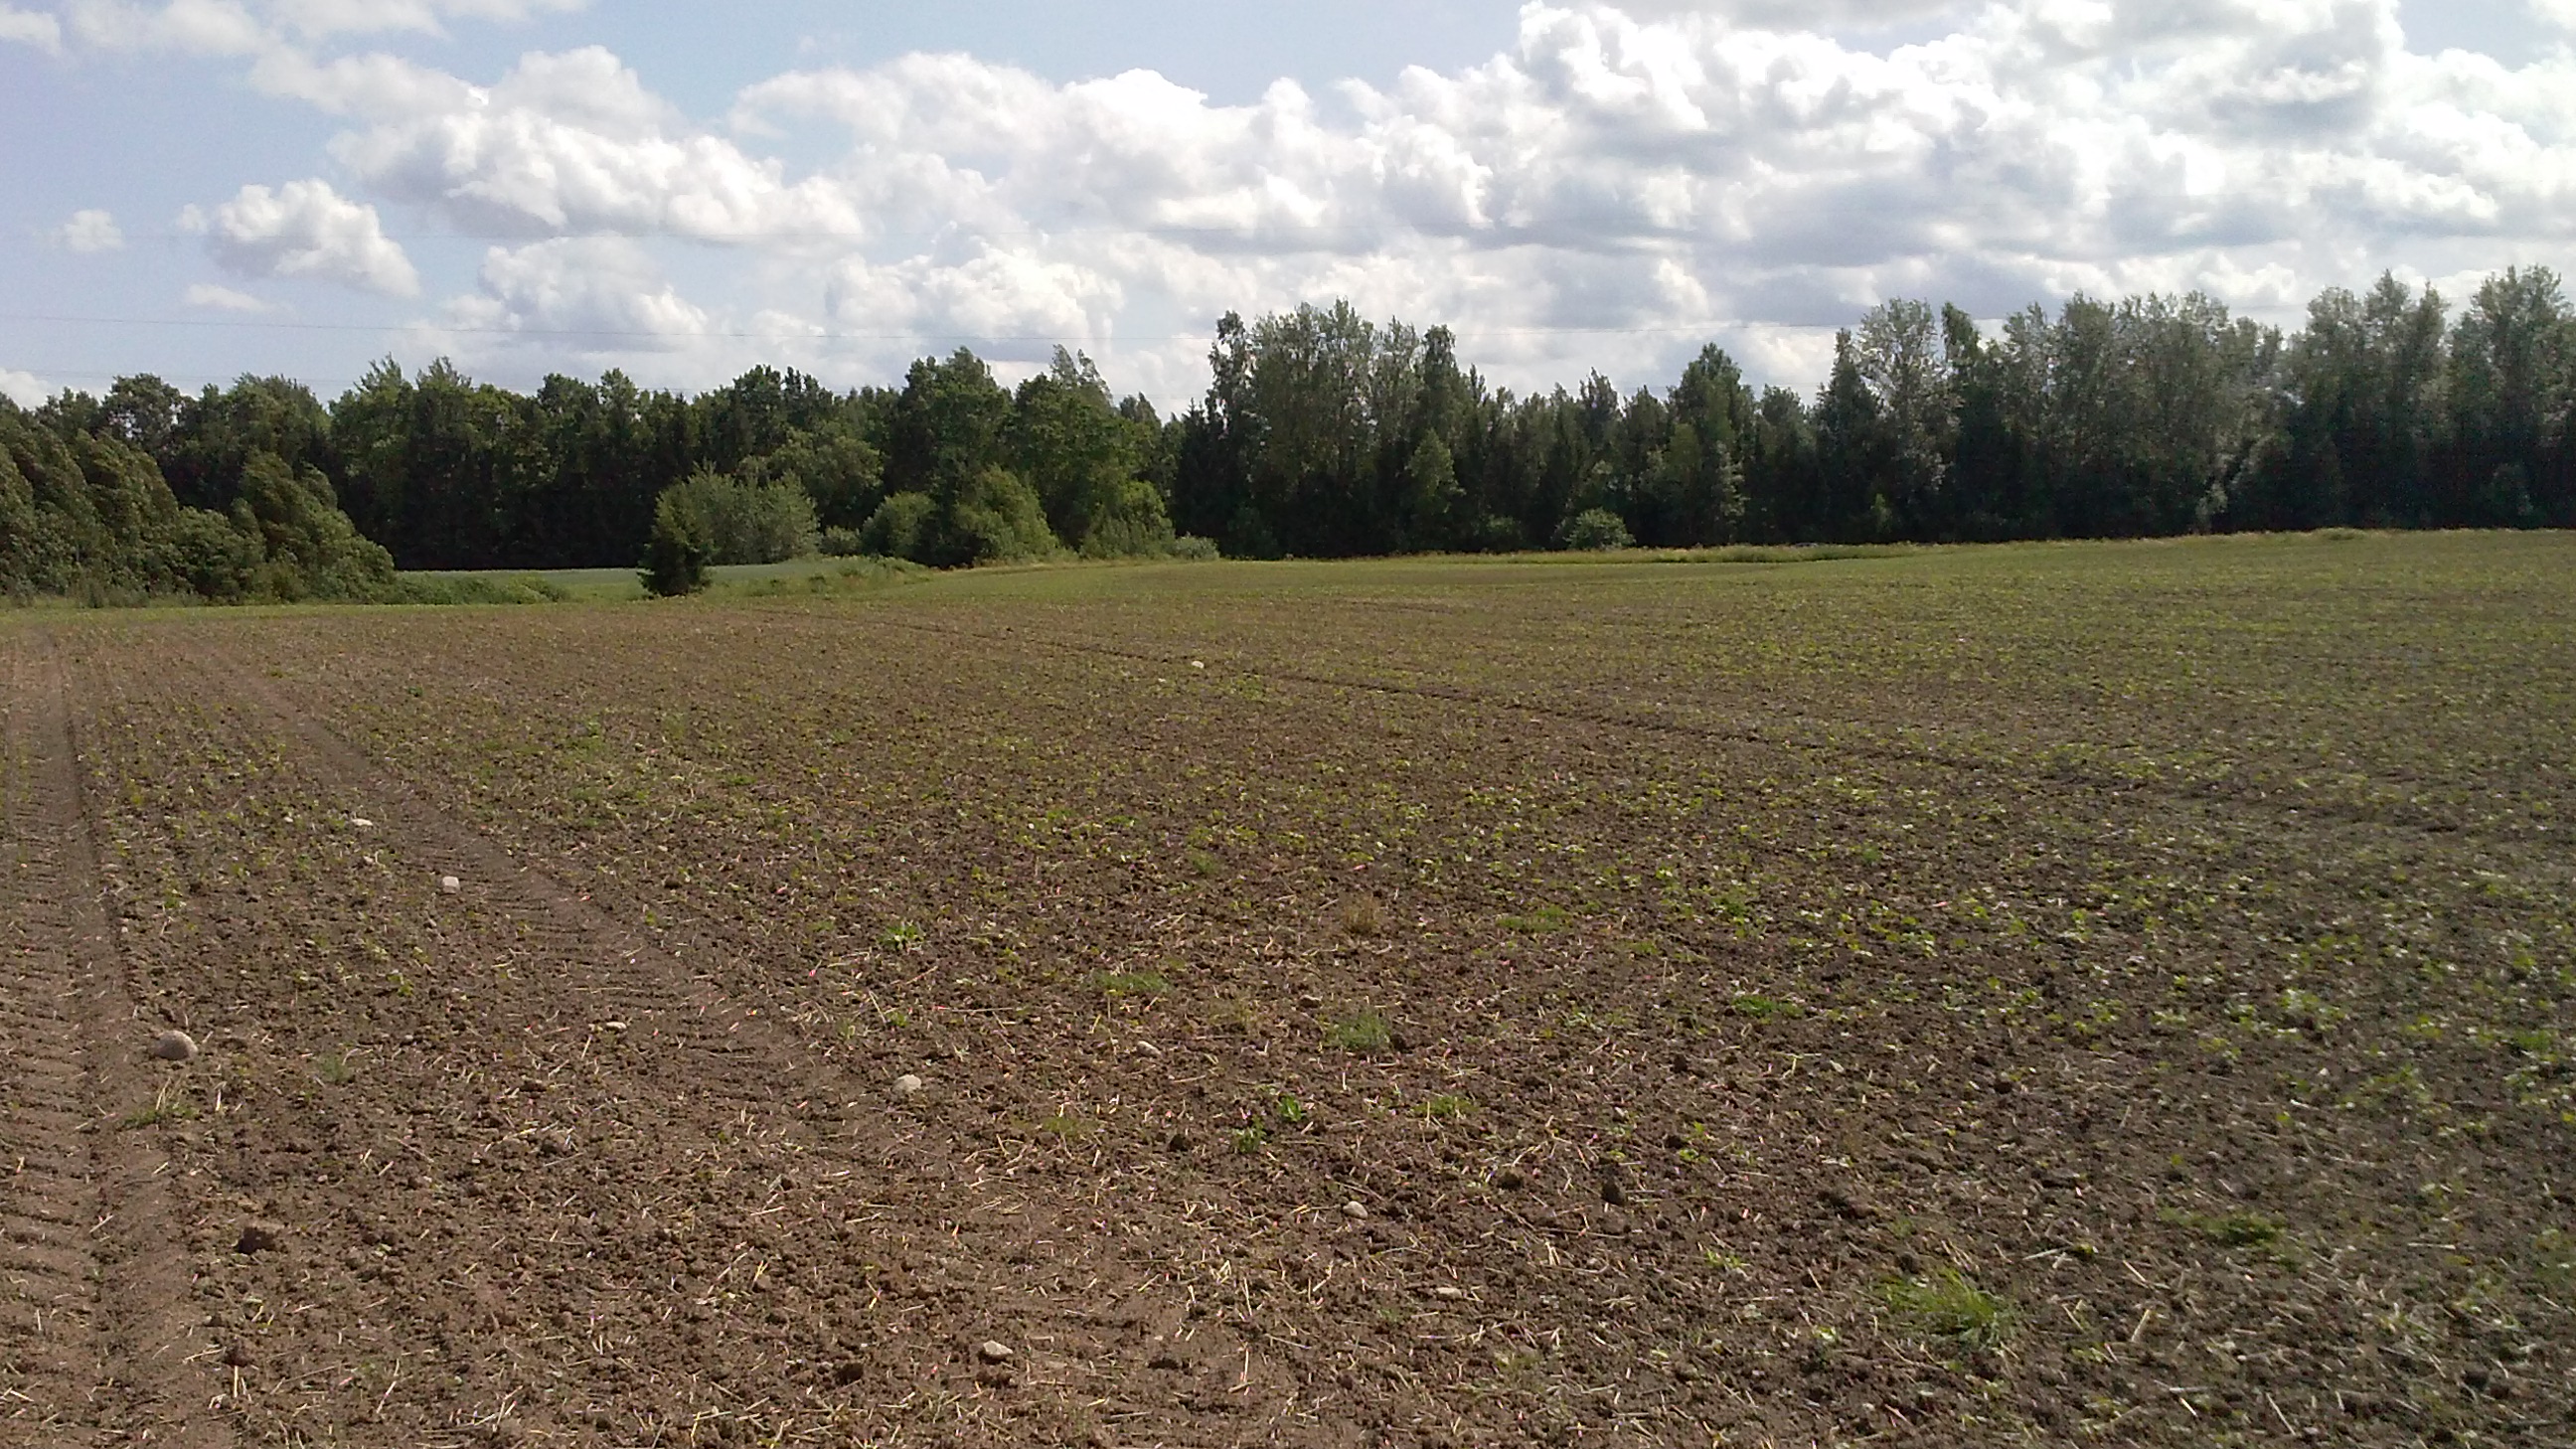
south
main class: Cropland
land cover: Other cereals
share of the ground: < 10 %
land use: Agriculture (excluding fallow land and kitchen gardens)
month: July
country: LV
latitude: 56.5397
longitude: 27.4984
